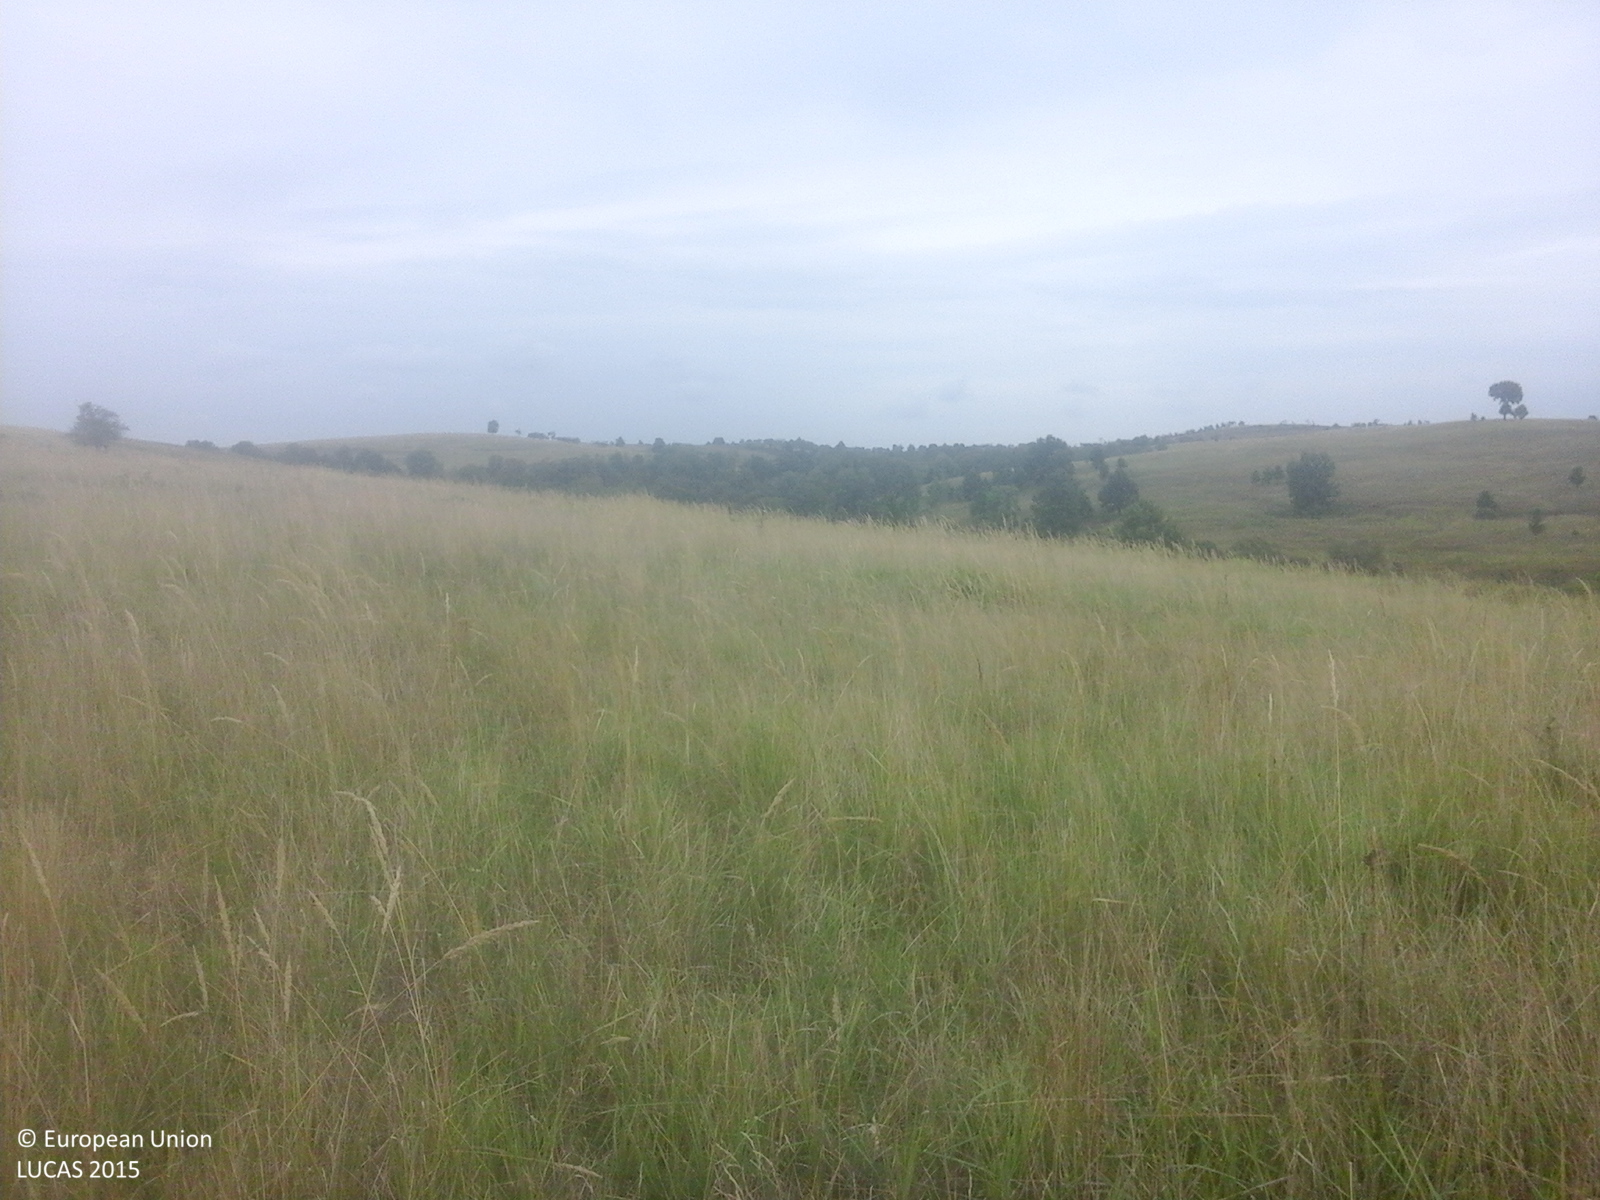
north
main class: Grassland
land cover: Grassland without tree/shrub cover
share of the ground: > 75 %
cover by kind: herbaceous plants 100 %
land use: Agriculture (excluding fallow land and kitchen gardens)
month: September
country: RO
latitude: 45.8811
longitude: 22.0894
